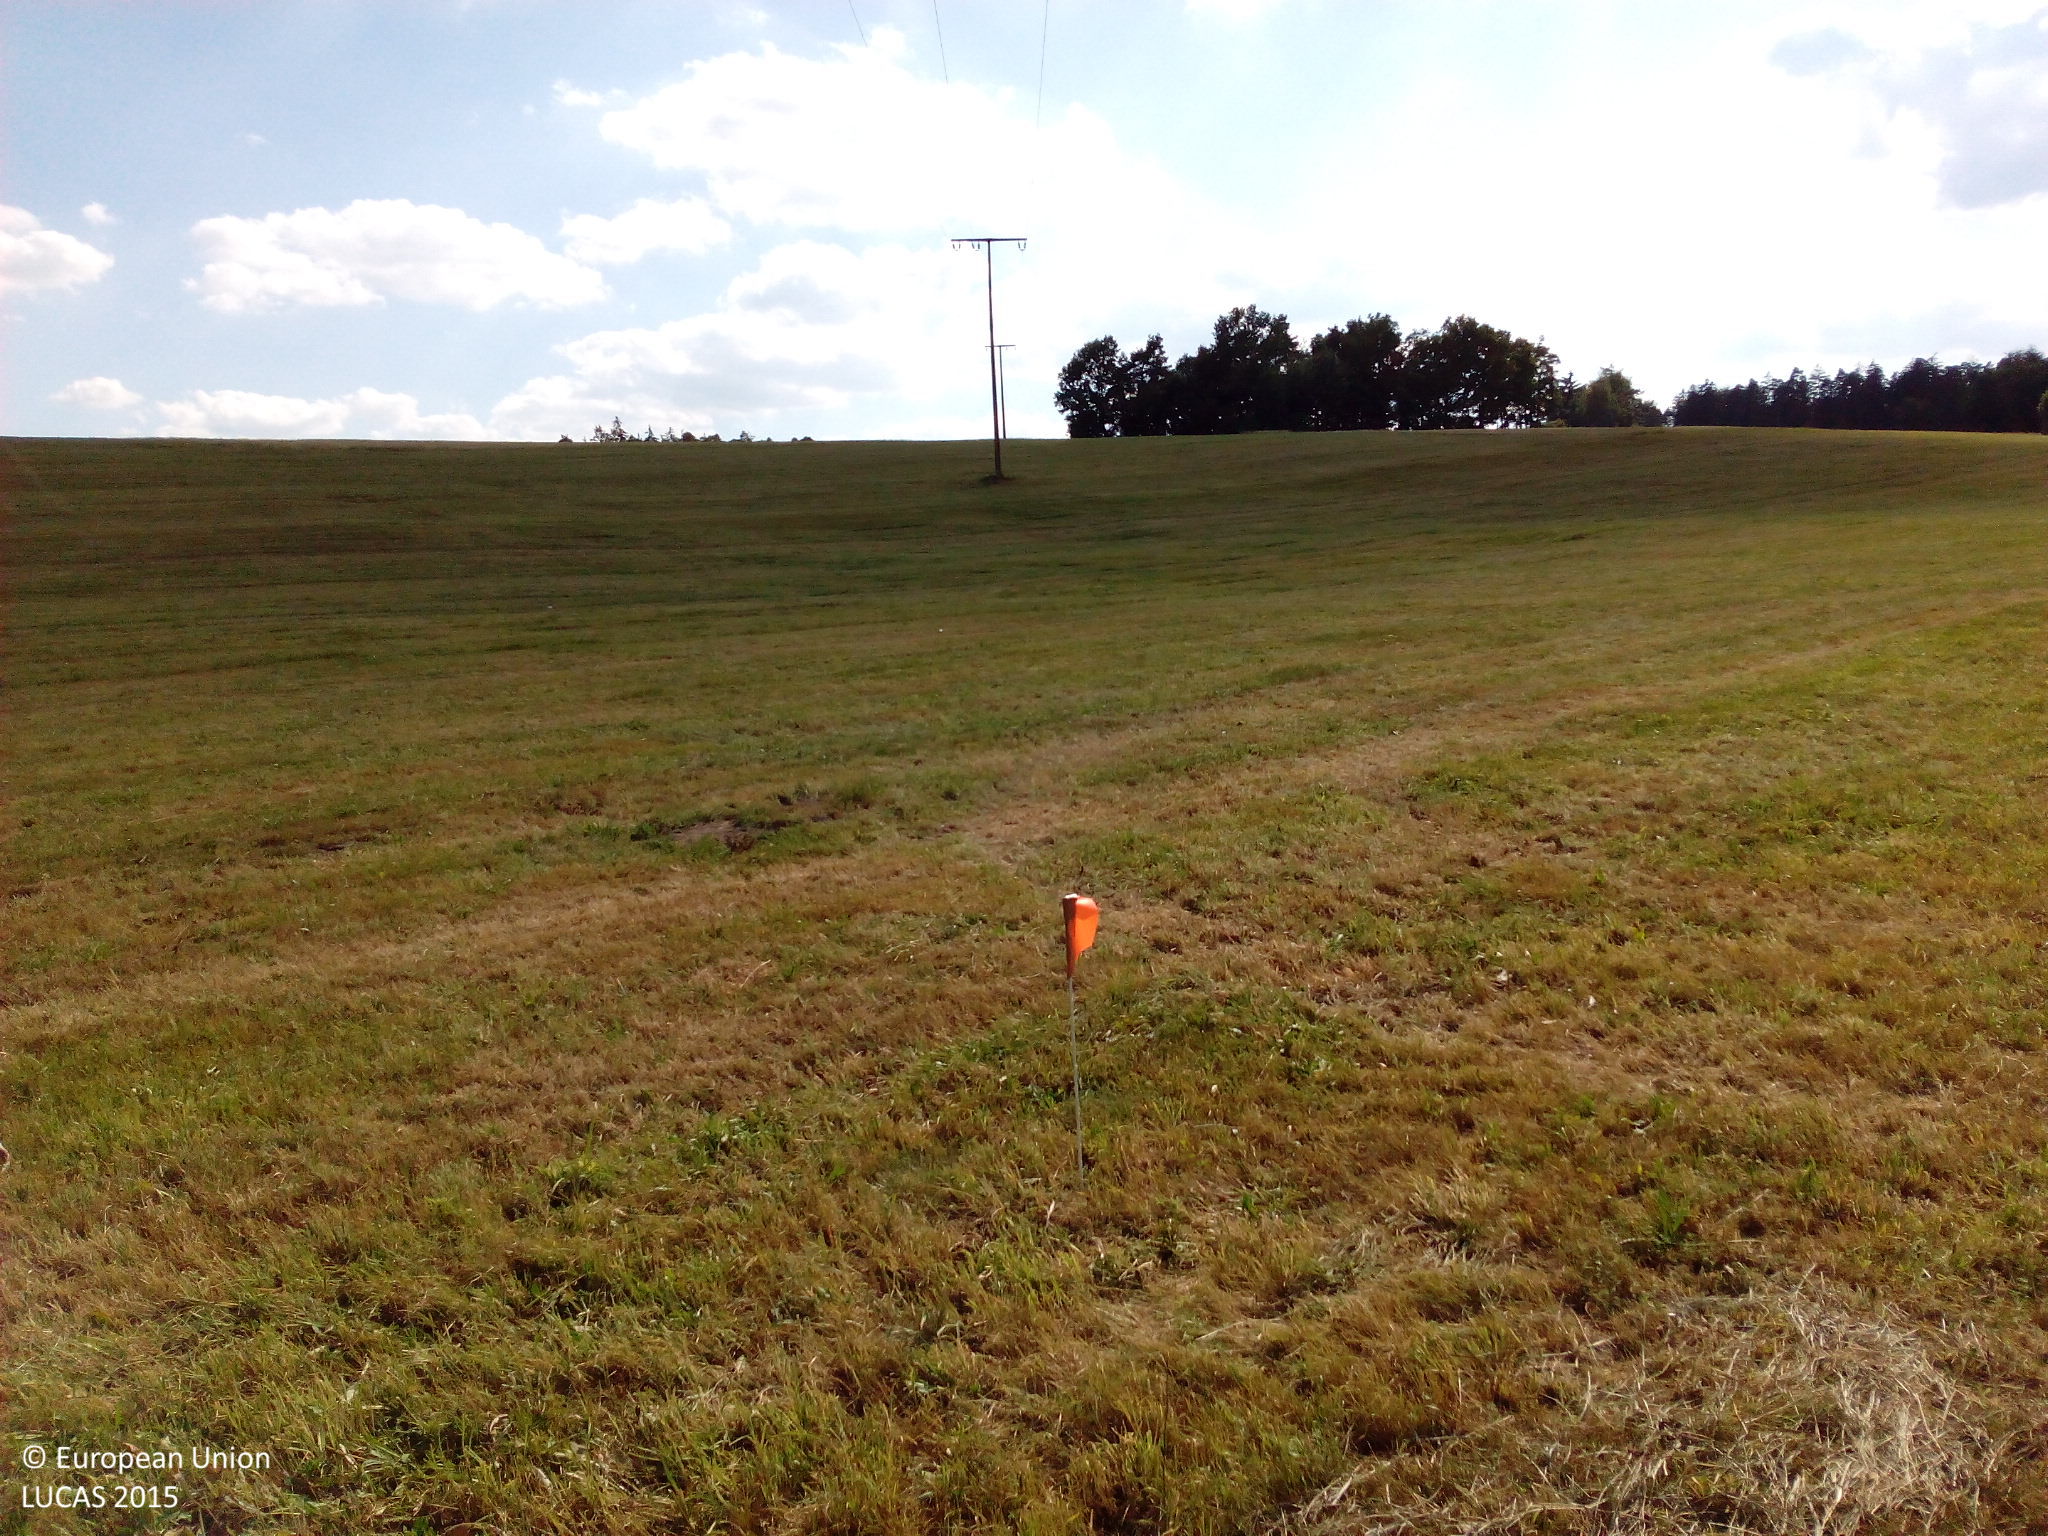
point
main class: Grassland
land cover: Grassland without tree/shrub cover
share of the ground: > 75 %
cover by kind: herbaceous plants 100 %
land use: Agriculture (excluding fallow land and kitchen gardens)
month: August
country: DE
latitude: 49.0329
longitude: 10.2598
